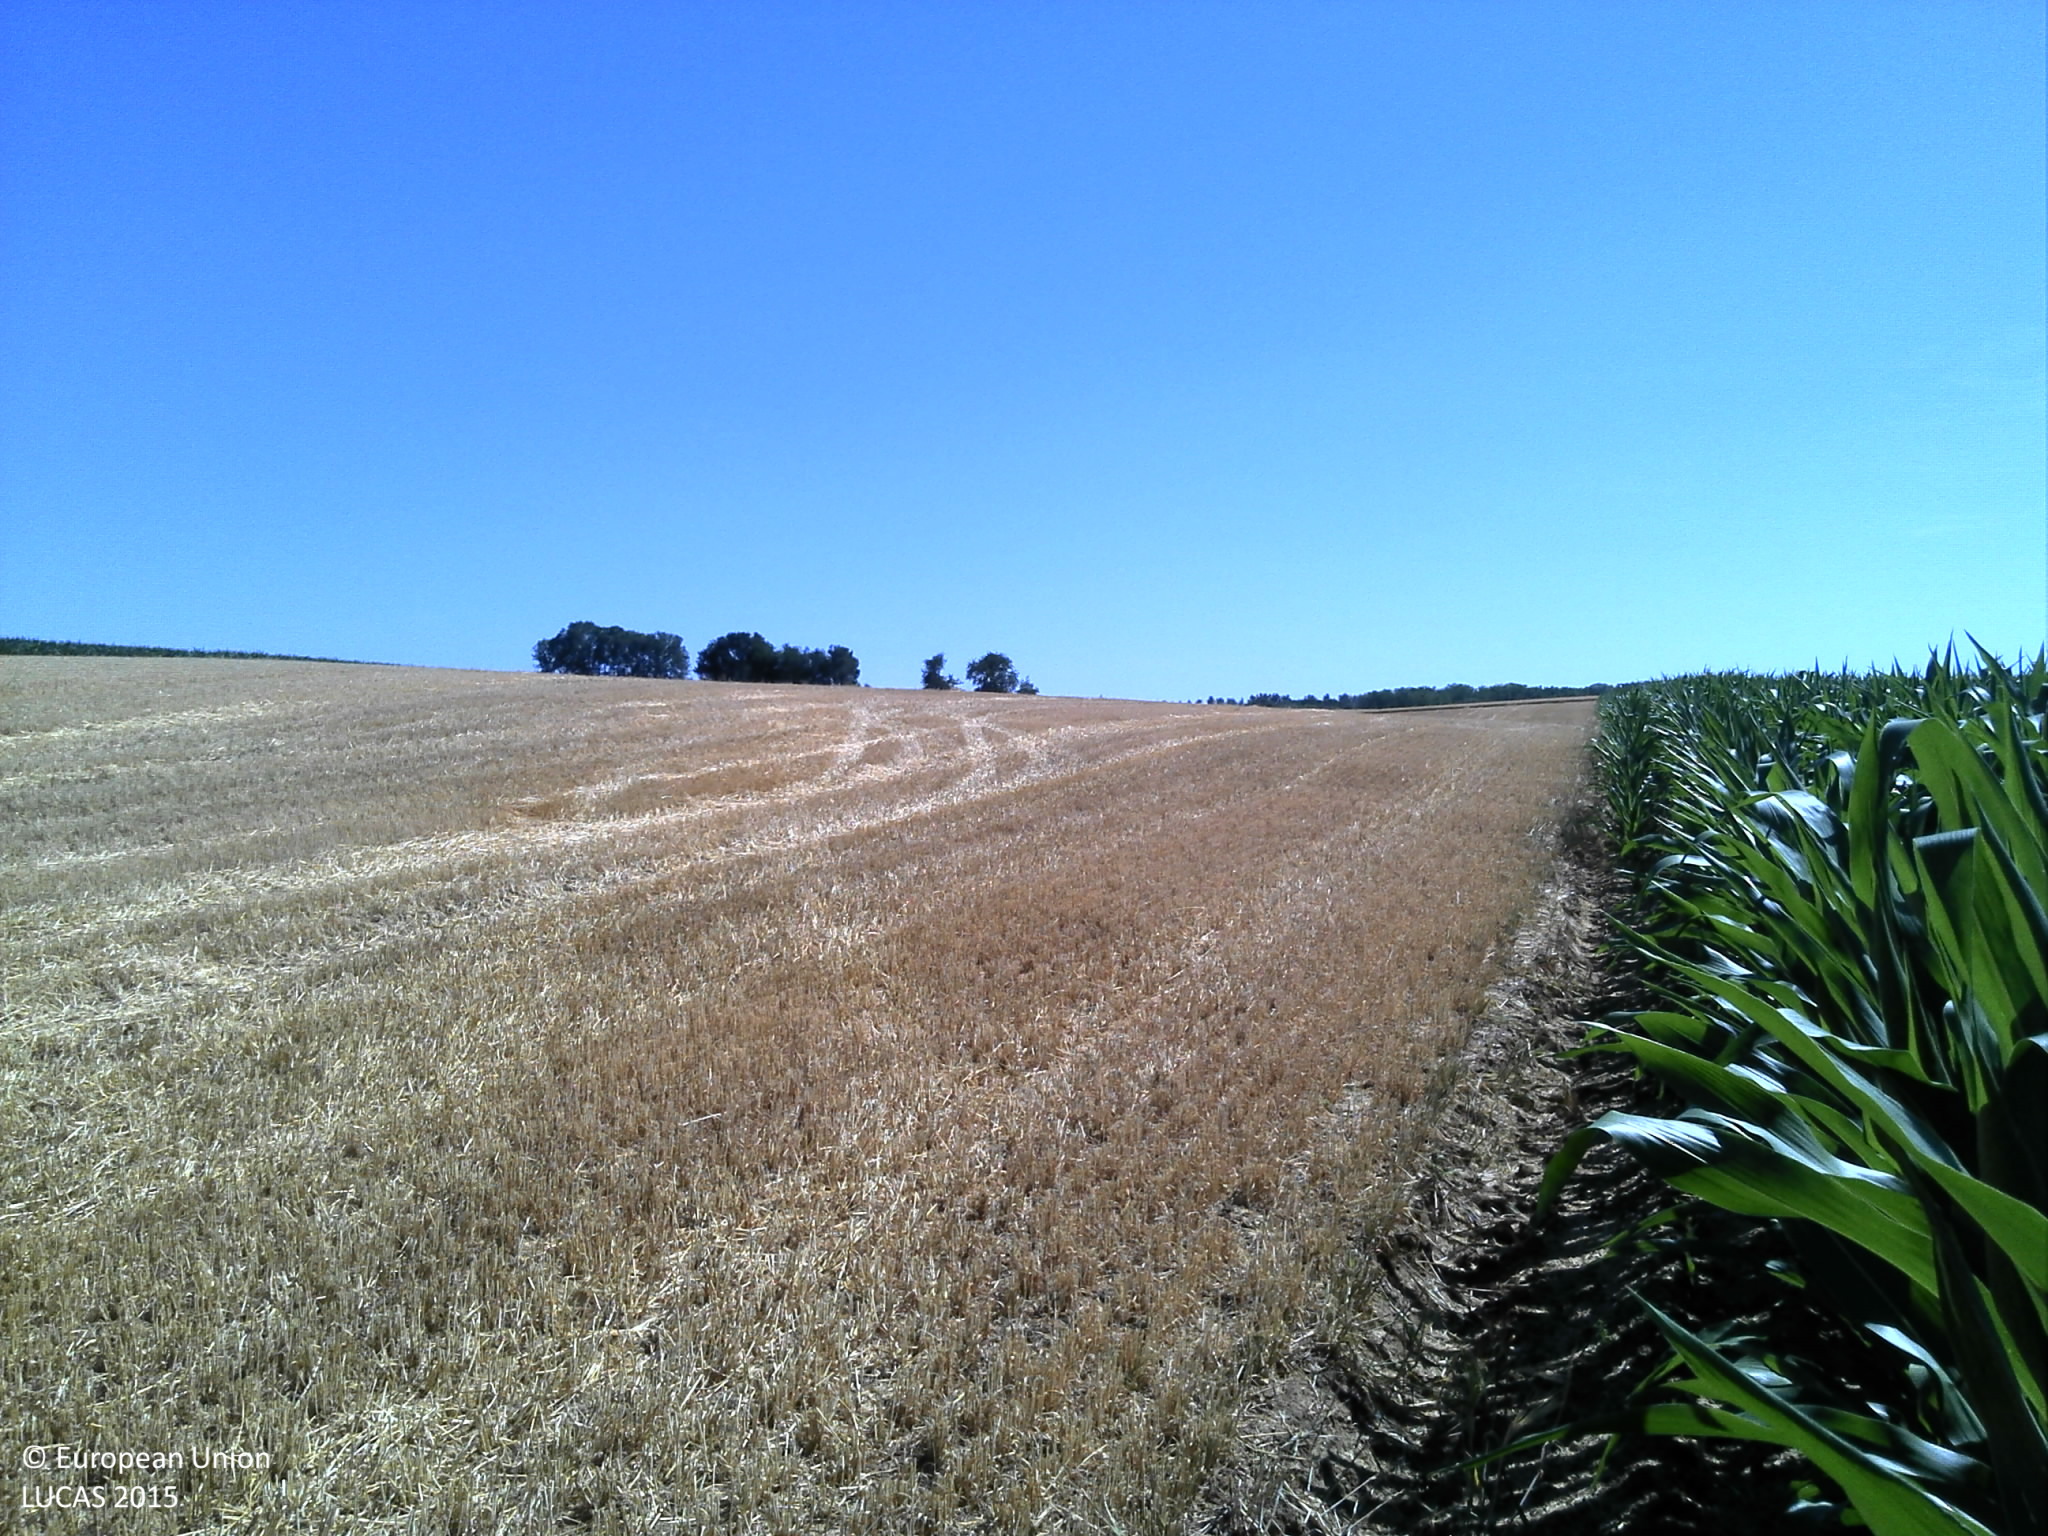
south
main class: Cropland
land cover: Maize
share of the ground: > 75 %
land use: Agriculture (excluding fallow land and kitchen gardens)
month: July
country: FR
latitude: 49.5065
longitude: 4.7907
